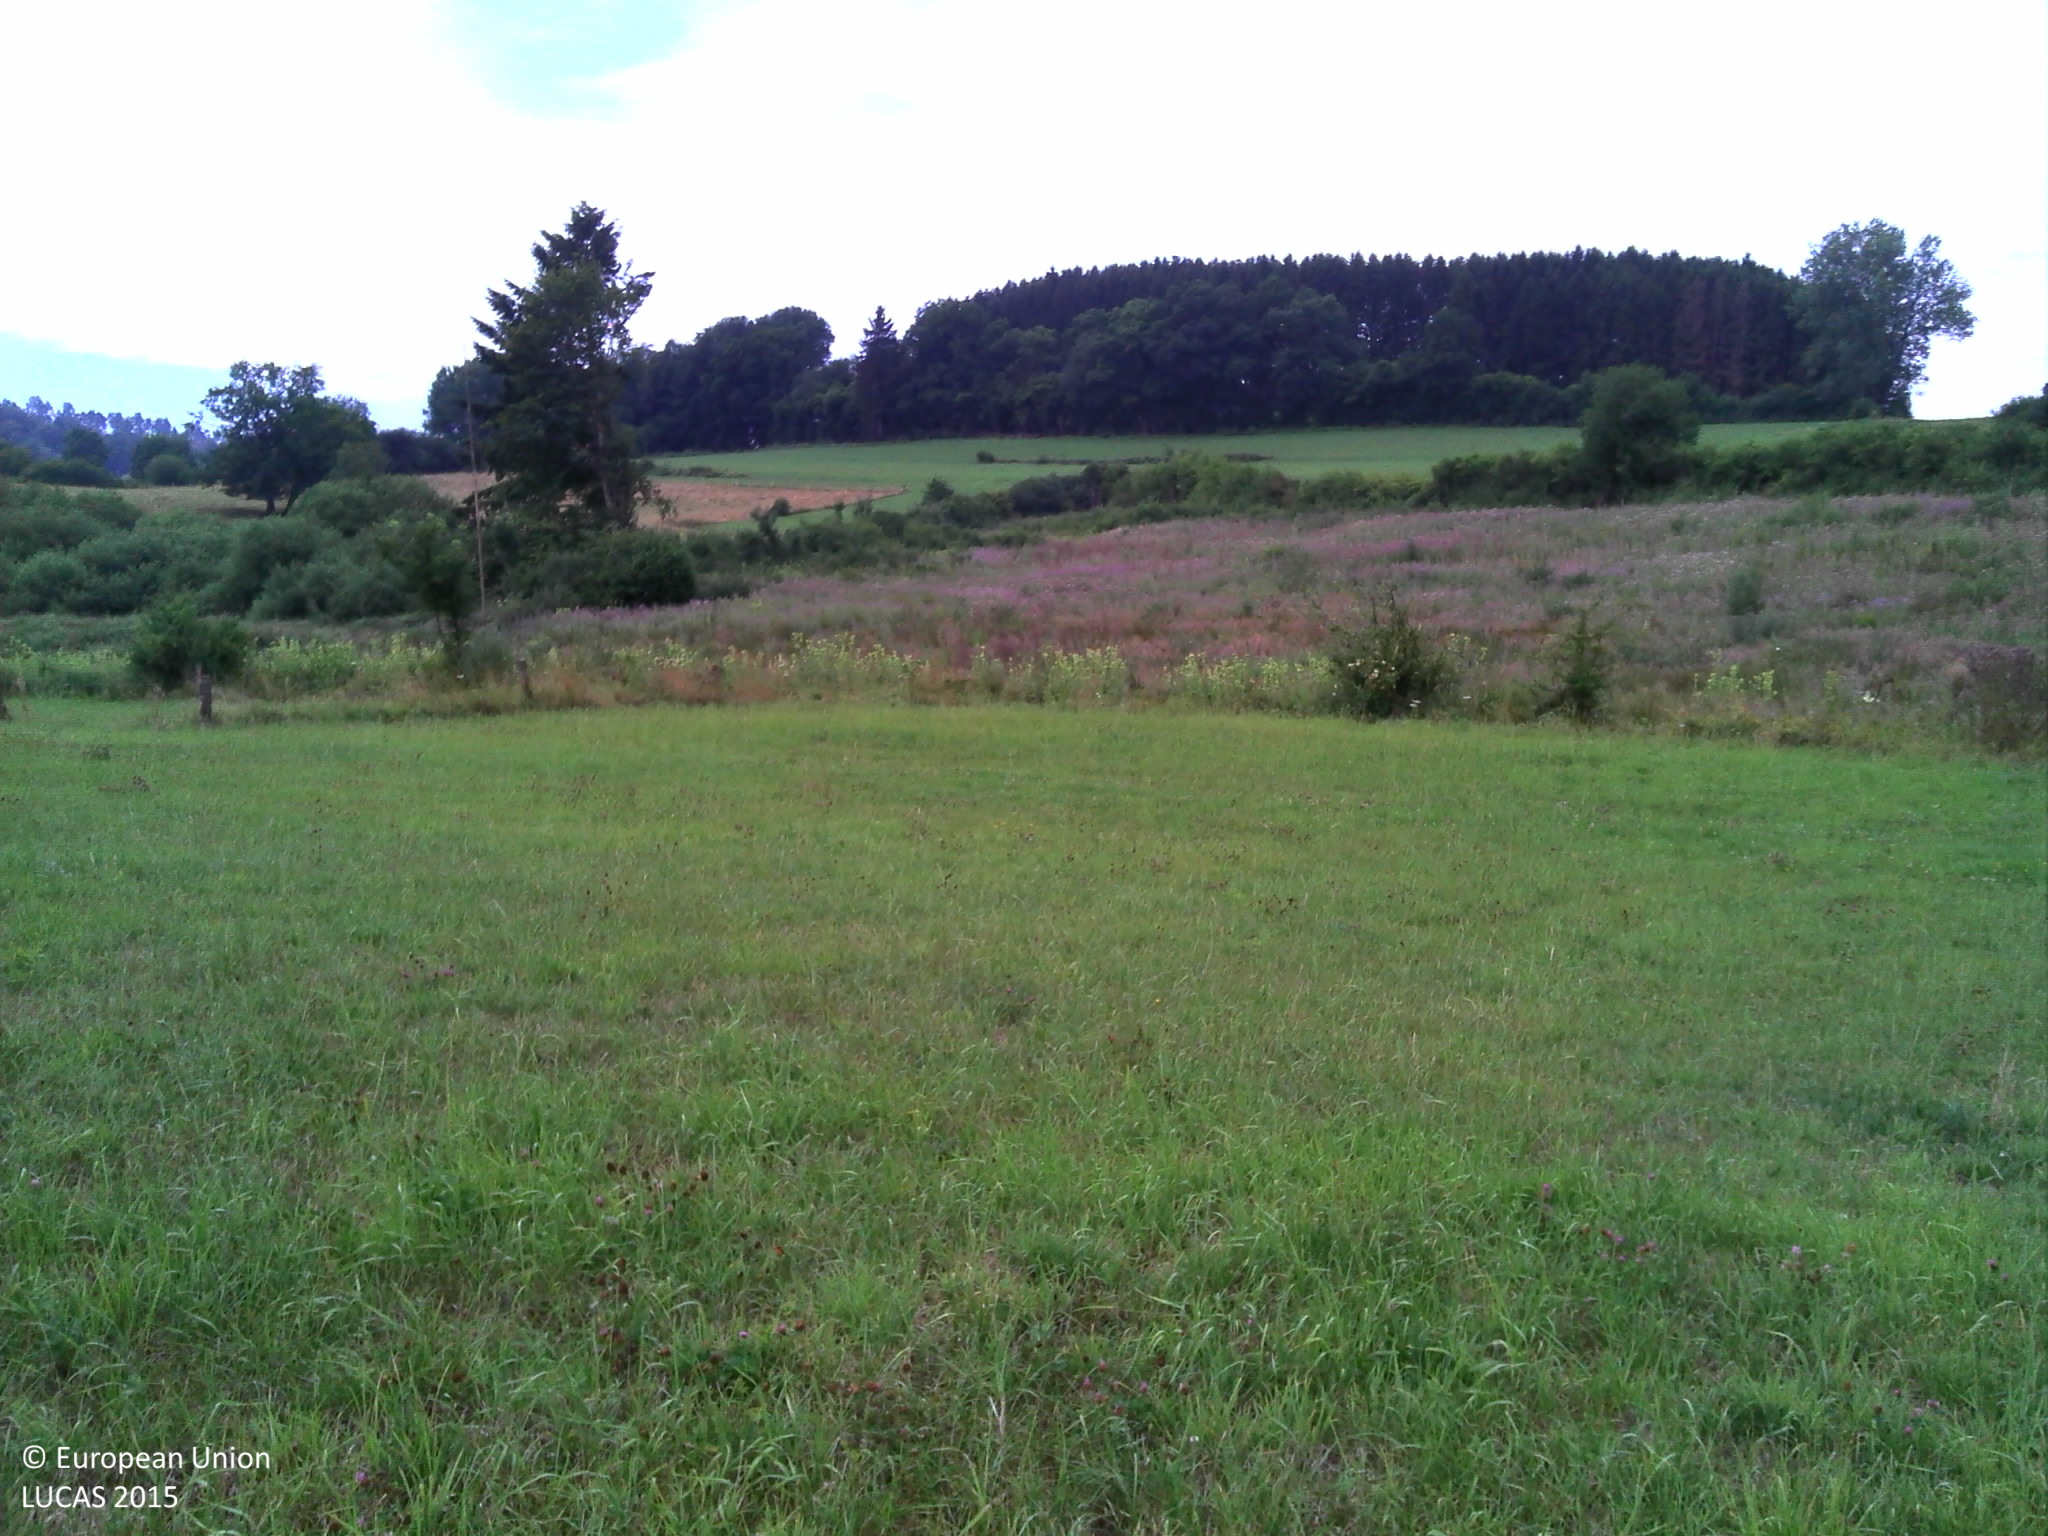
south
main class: Grassland
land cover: Grassland without tree/shrub cover
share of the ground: > 75 %
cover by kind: herbaceous plants 100 %
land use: Agriculture (excluding fallow land and kitchen gardens)
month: July
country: BE
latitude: 49.7265
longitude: 5.7400
